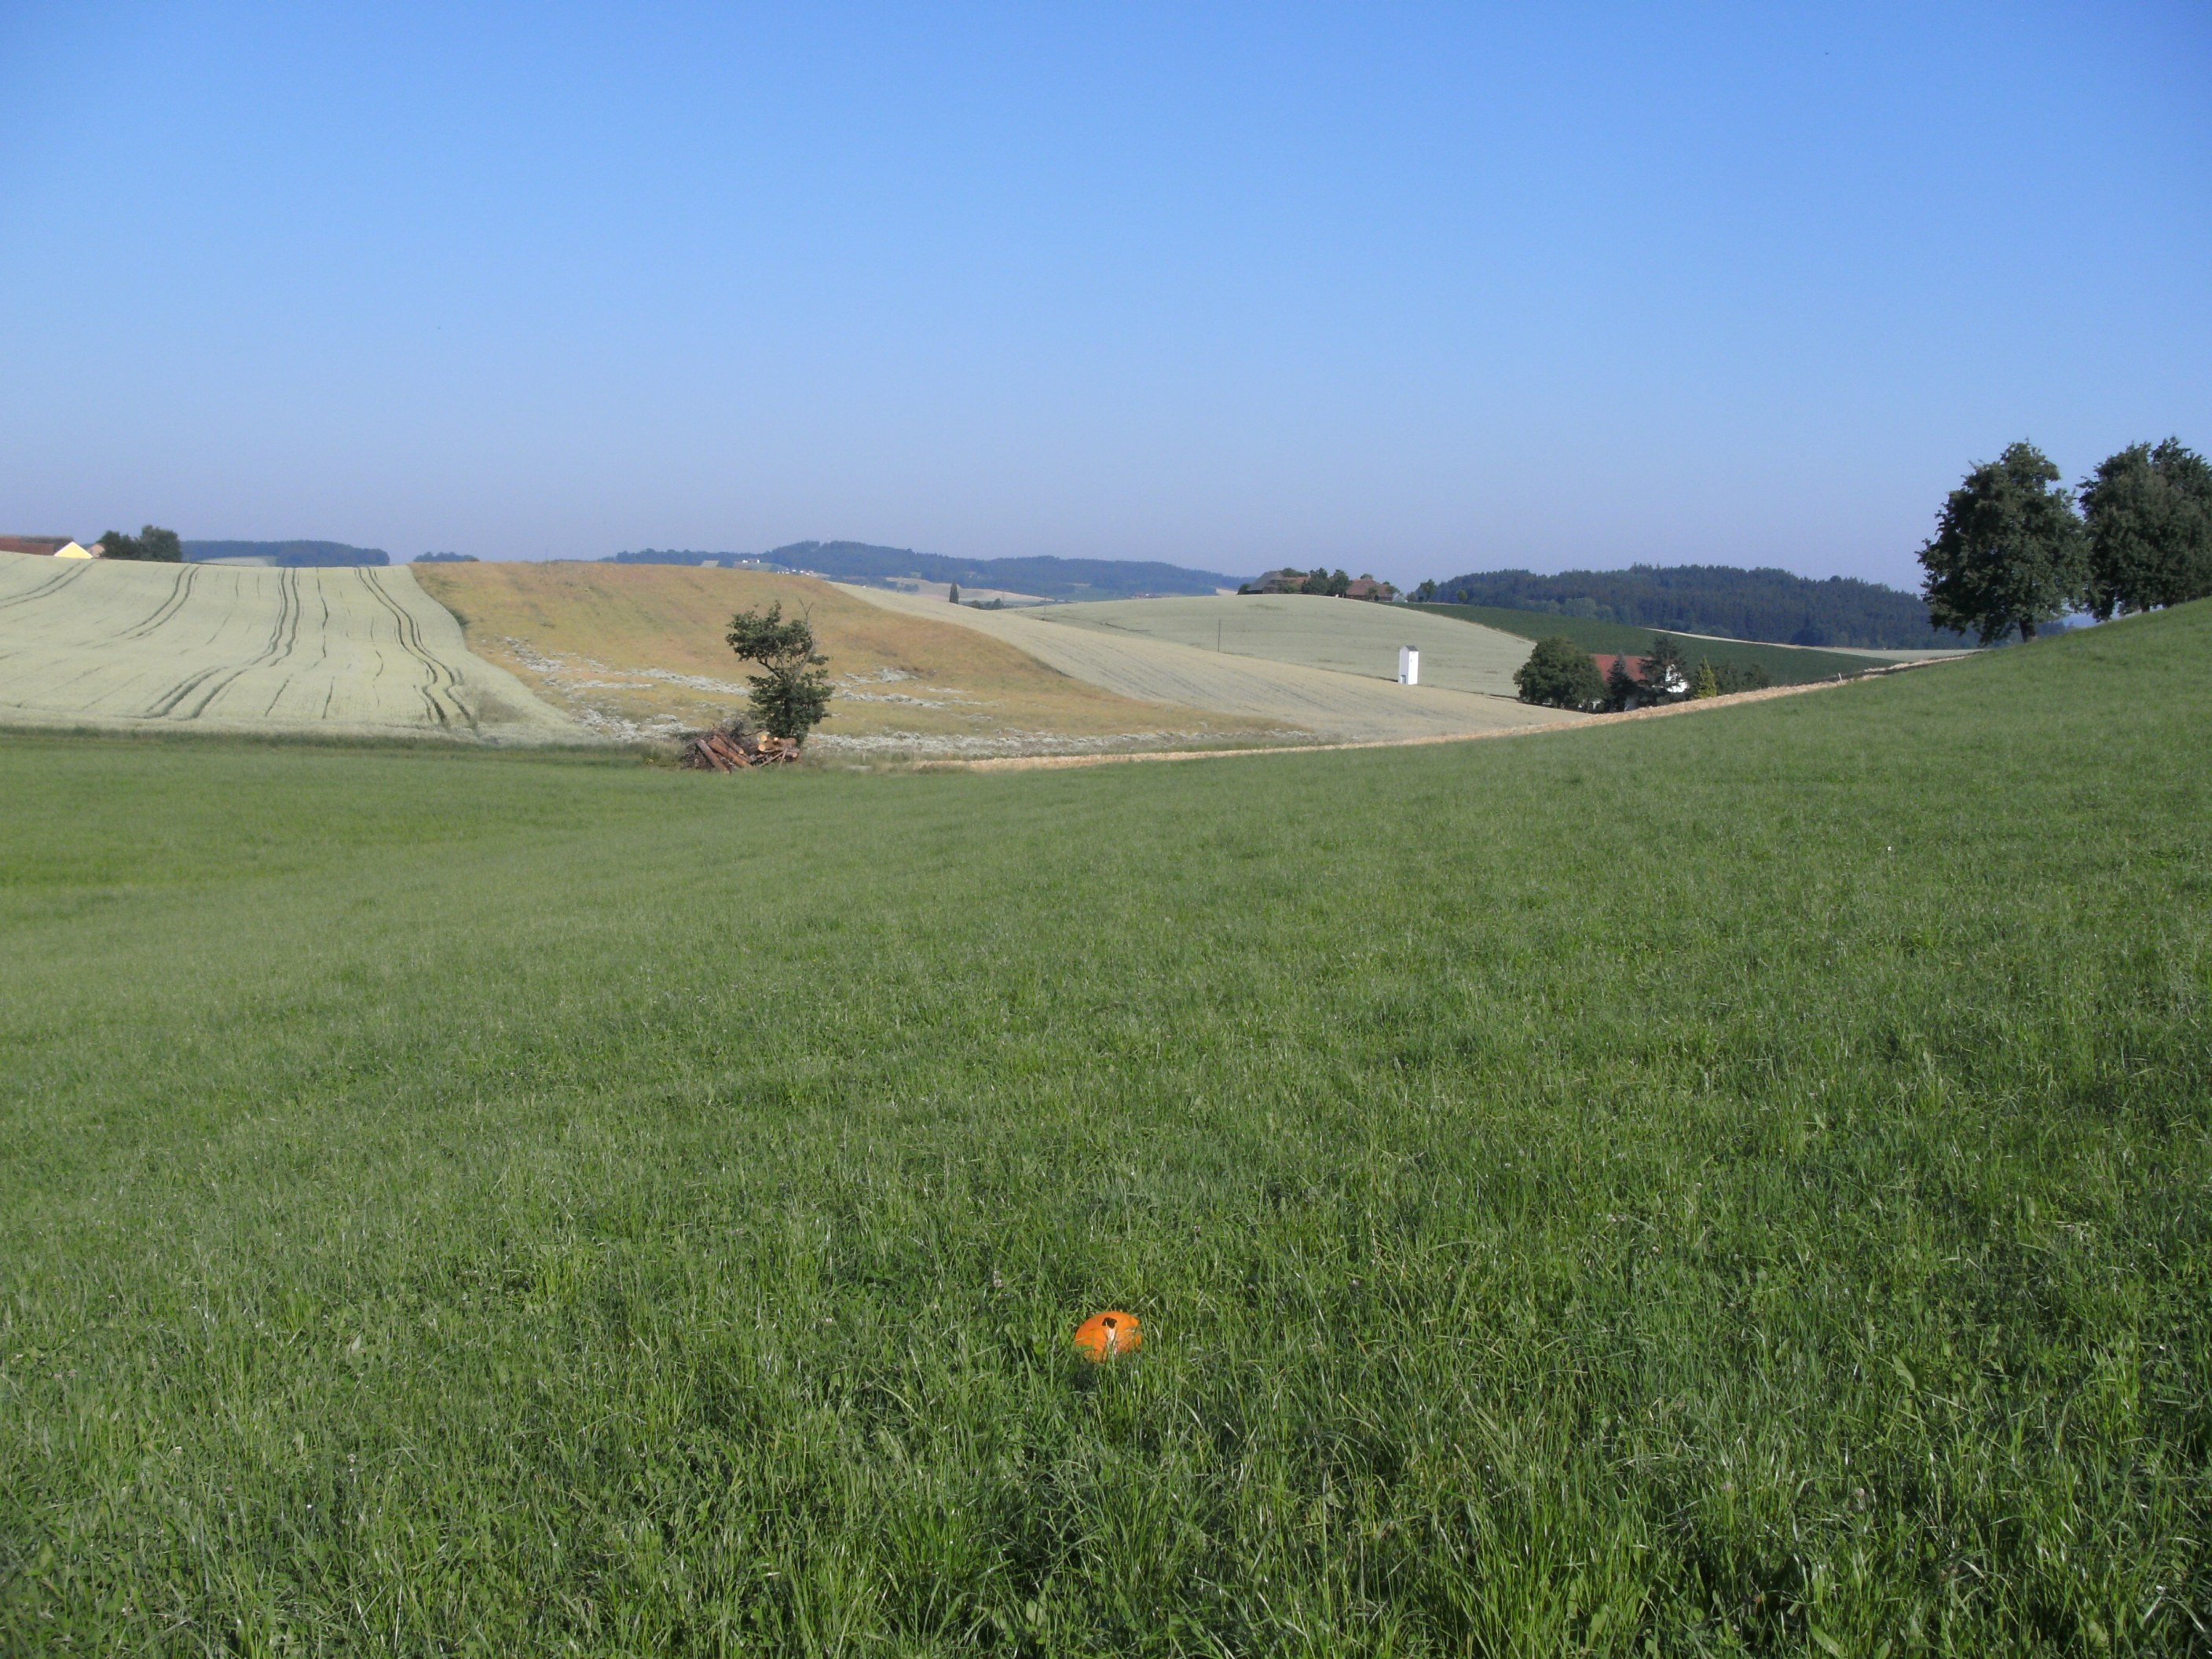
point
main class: Grassland
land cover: Grassland without tree/shrub cover
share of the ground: > 75 %
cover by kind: herbaceous plants 100 %
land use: Agriculture (excluding fallow land and kitchen gardens)
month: July
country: AT
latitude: 48.1677
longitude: 13.5087
